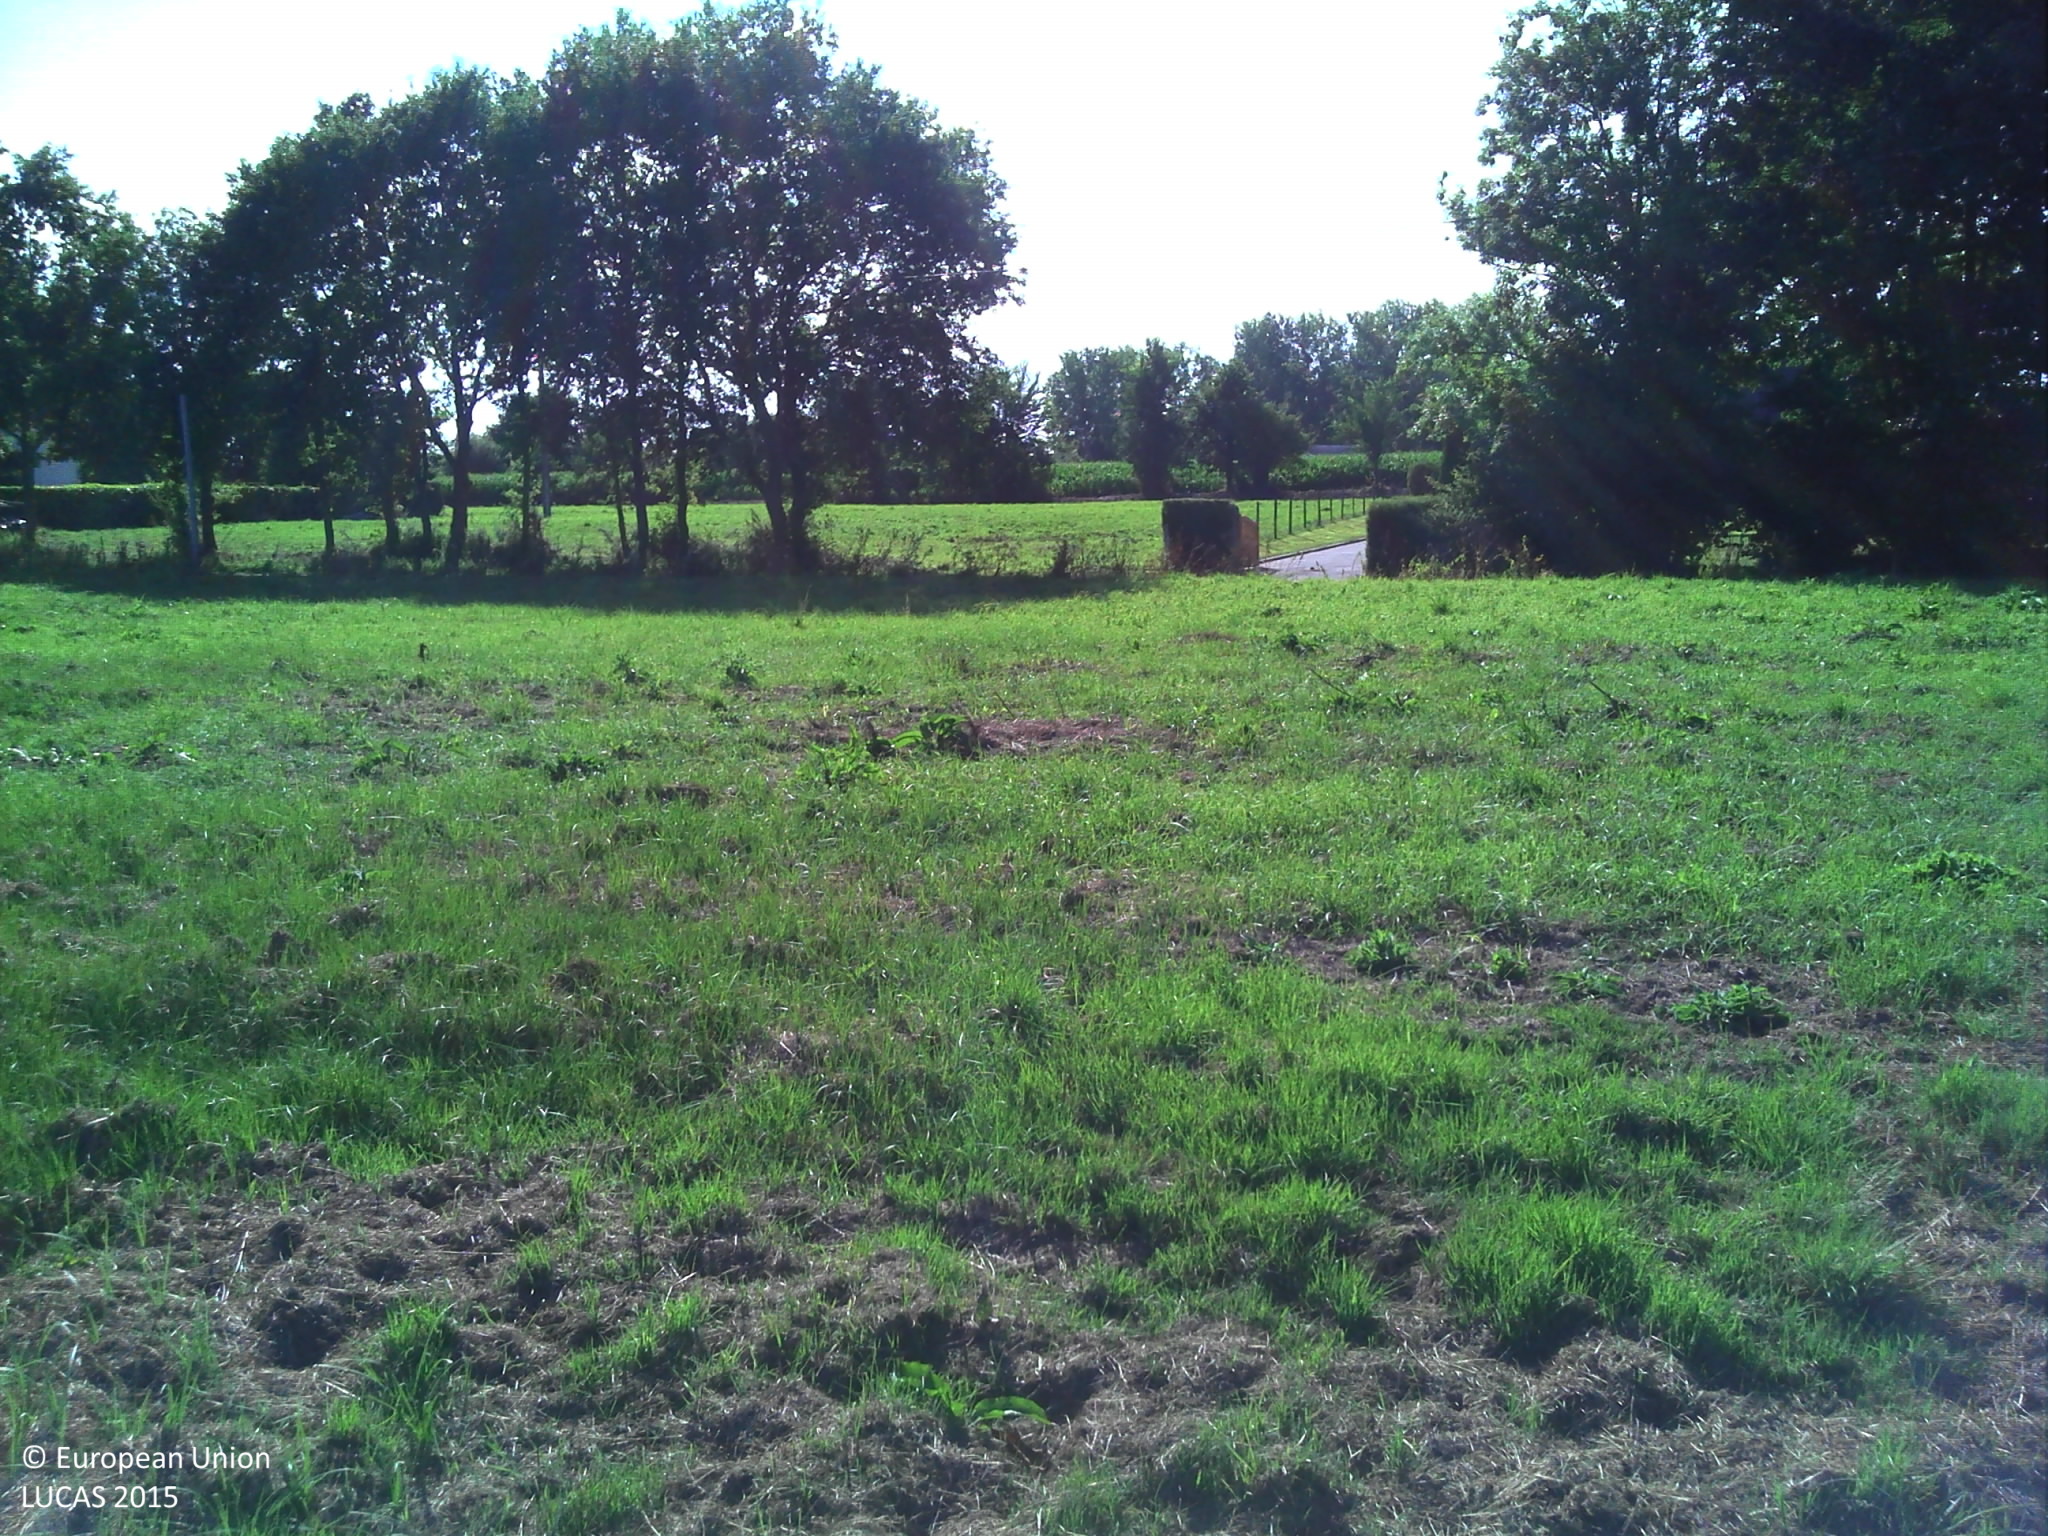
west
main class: Grassland
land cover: Grassland without tree/shrub cover
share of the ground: > 75 %
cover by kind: herbaceous plants 100 %
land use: Agriculture (excluding fallow land and kitchen gardens)
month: August
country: FR
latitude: 48.6196
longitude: -1.3181
